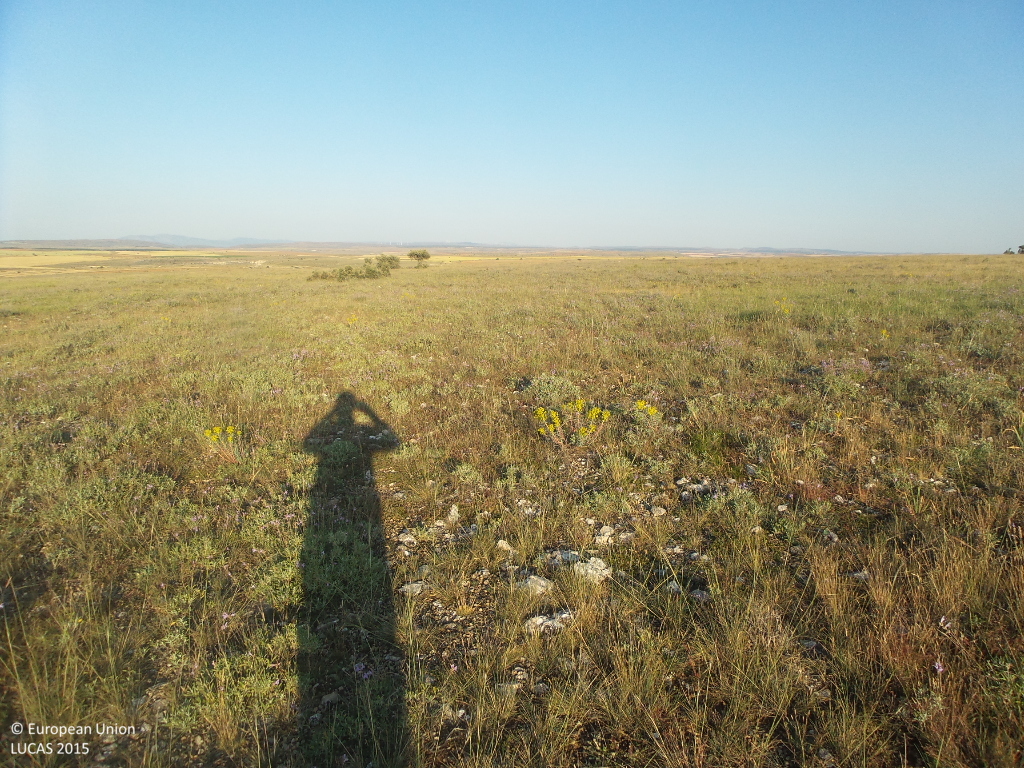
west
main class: Shrubland
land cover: Shrubland without tree cover
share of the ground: 25 - 50 %
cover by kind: shrubs 40 %, herbaceous plants 40 %, unconsolidated bare surface 20 %
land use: Semi-natural and natural areas not in use
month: June
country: ES
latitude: 41.3377
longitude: -2.7149
